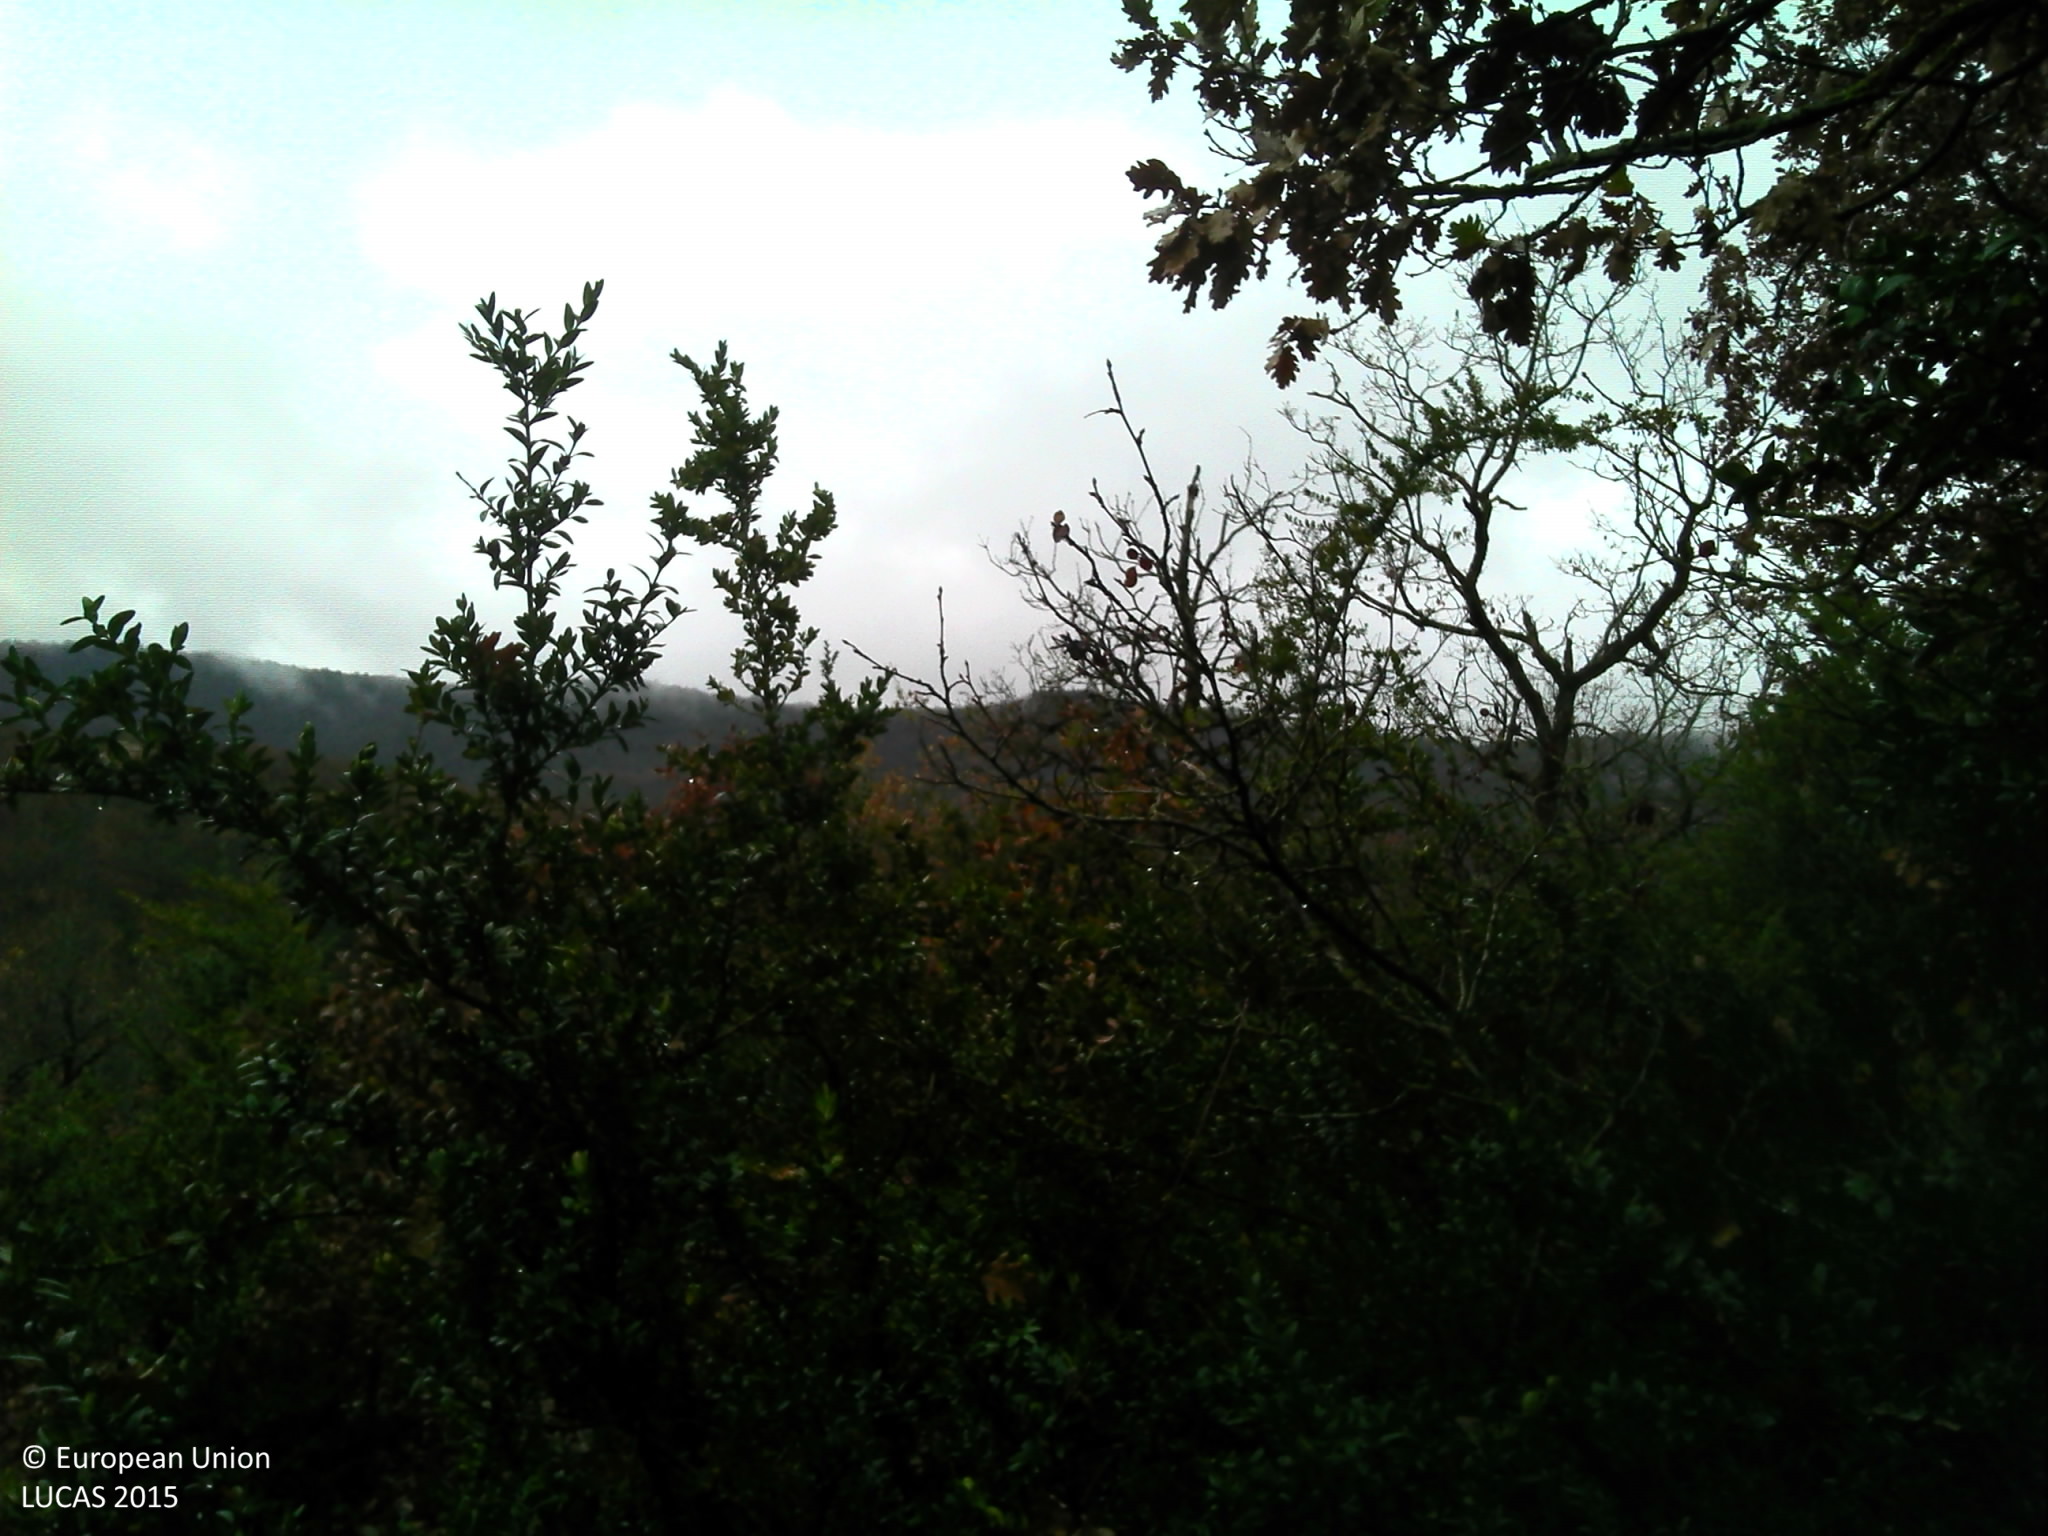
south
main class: Woodland
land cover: Broadleaved woodland
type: mesophytic deciduous forest
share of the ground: > 75 %
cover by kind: broadleaved forest trees 100 %
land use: Forestry
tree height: > 5 m
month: November
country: FR
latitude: 44.0061
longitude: 3.0092
